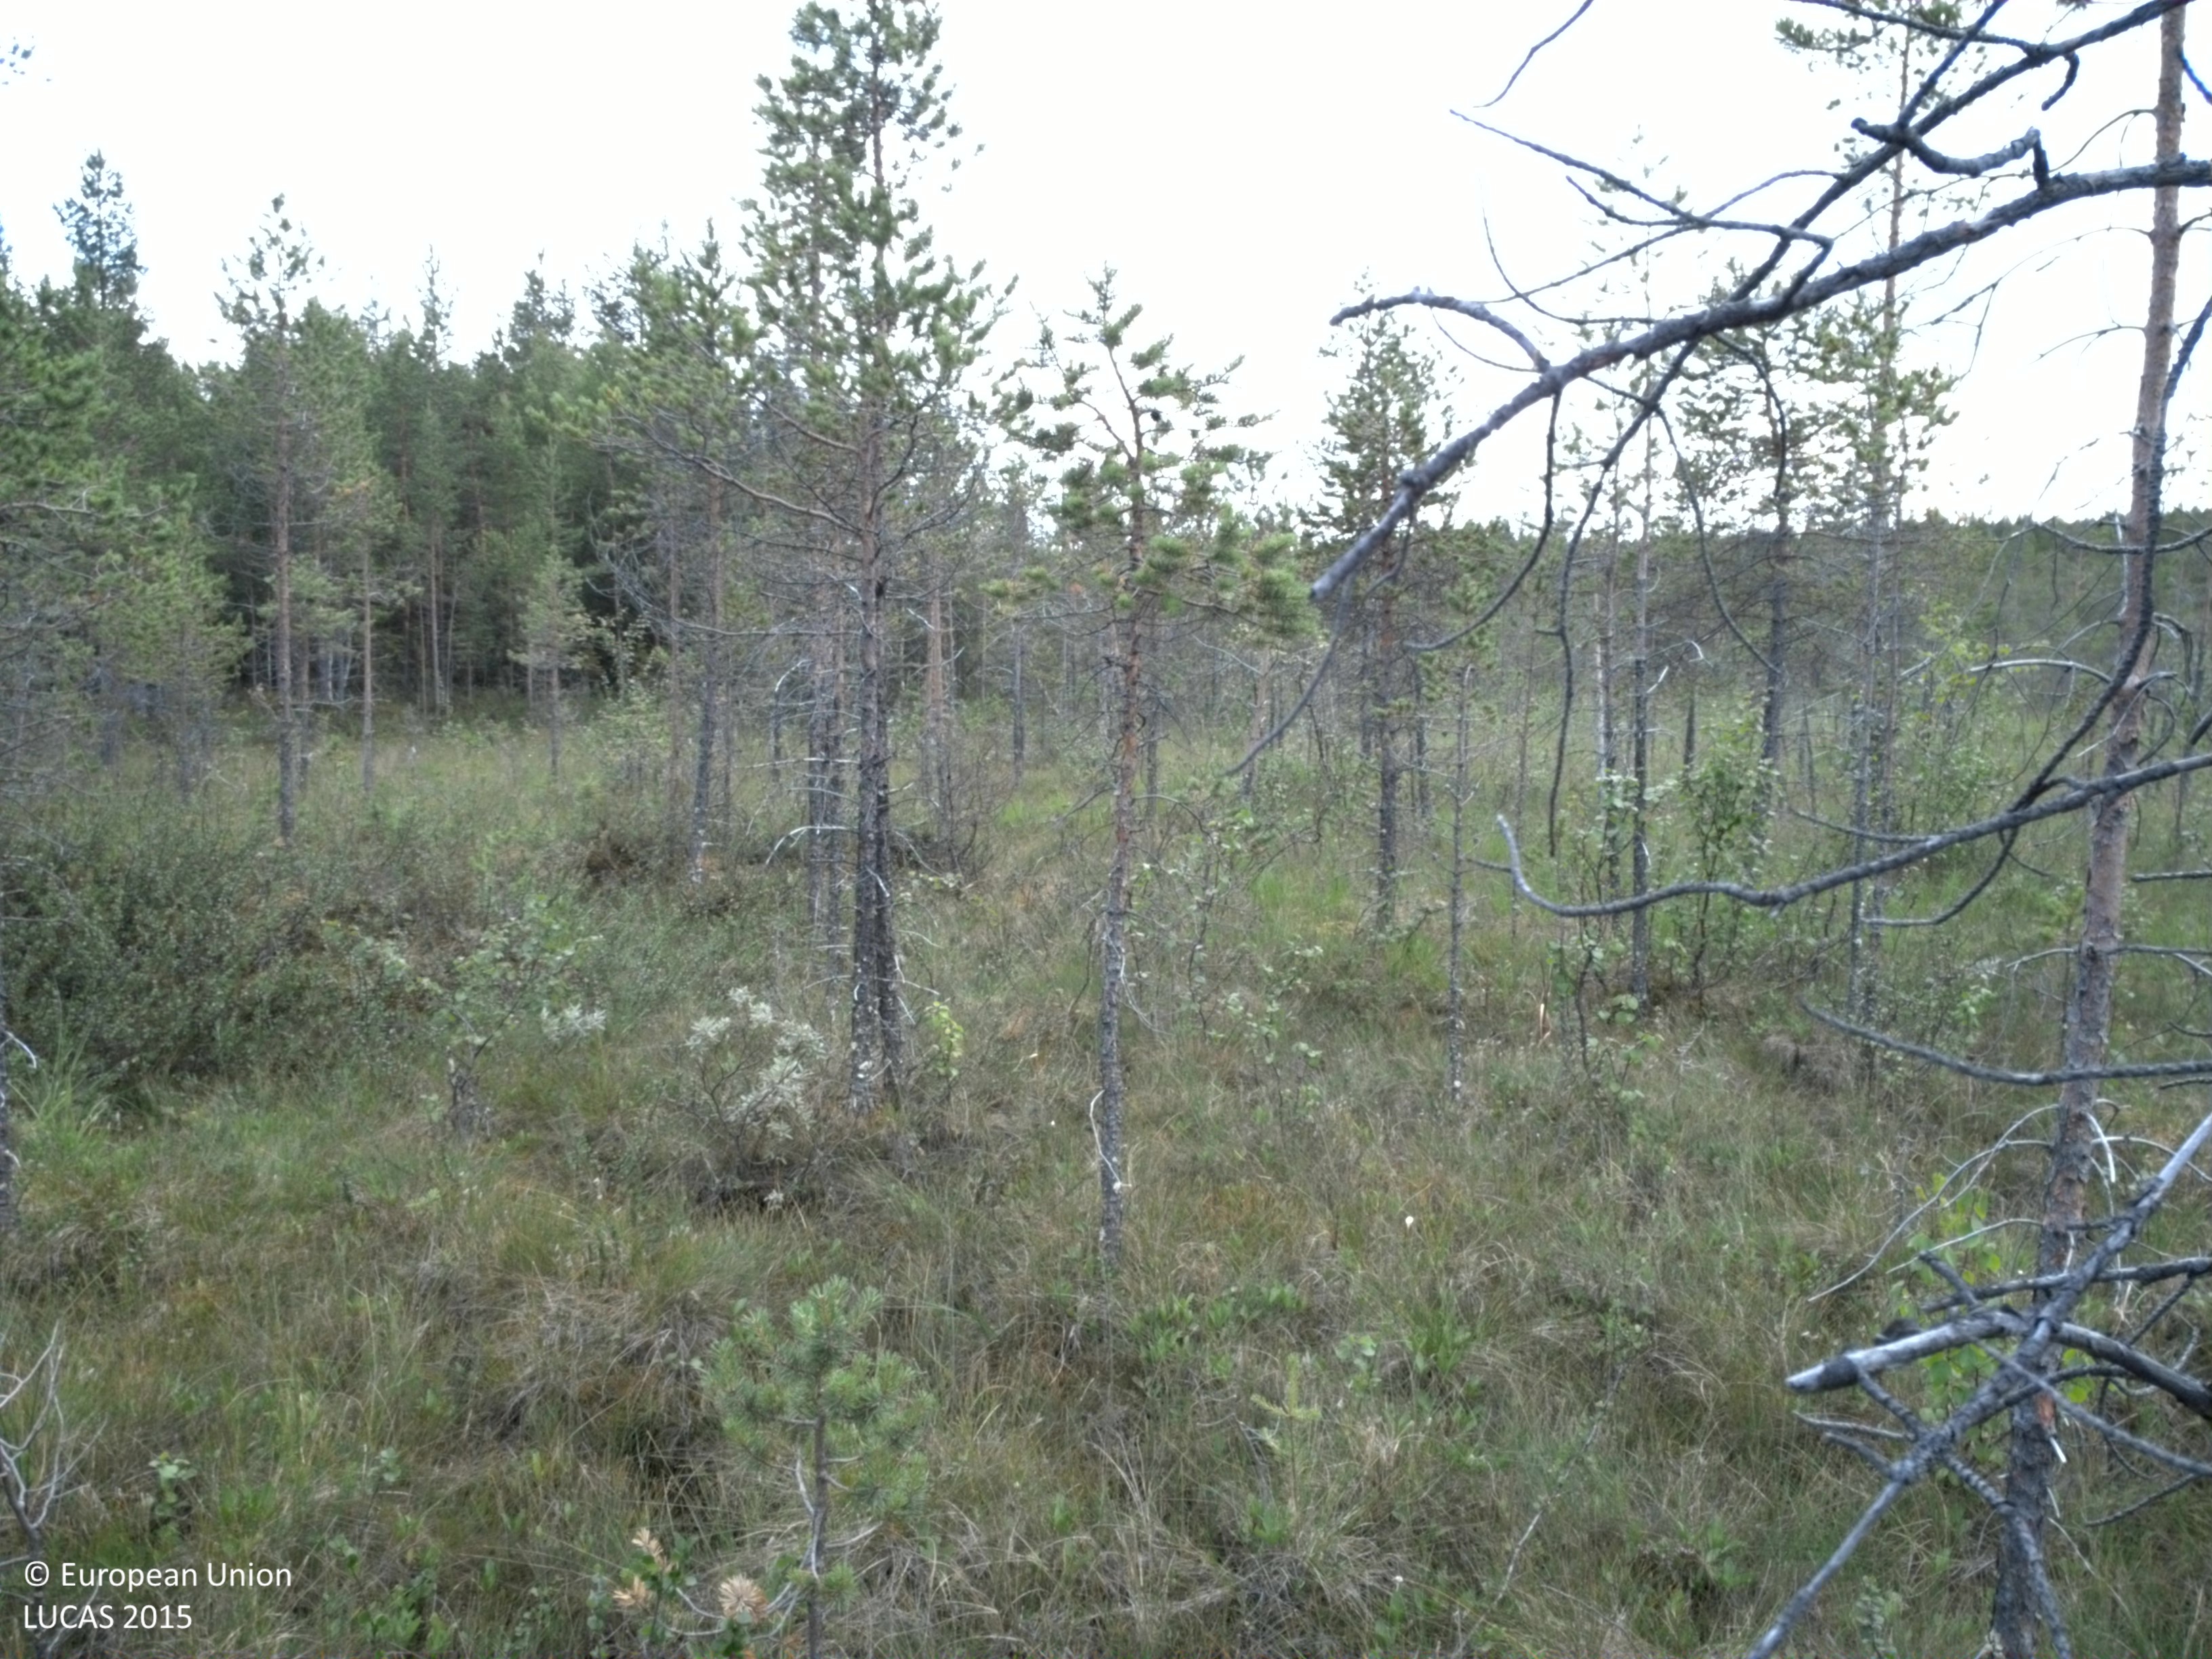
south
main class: Woodland
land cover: Pine dominated coniferous woodland
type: mire and swamp forests
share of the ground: 10 - 25 %
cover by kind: herbaceous plants 50 %, shrubs 30 %, coniferous forest trees 15 %, lichens and mosses 5 %
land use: Semi-natural and natural areas not in use
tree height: > 5 m
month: August
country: SE
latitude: 66.5678
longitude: 19.9361
